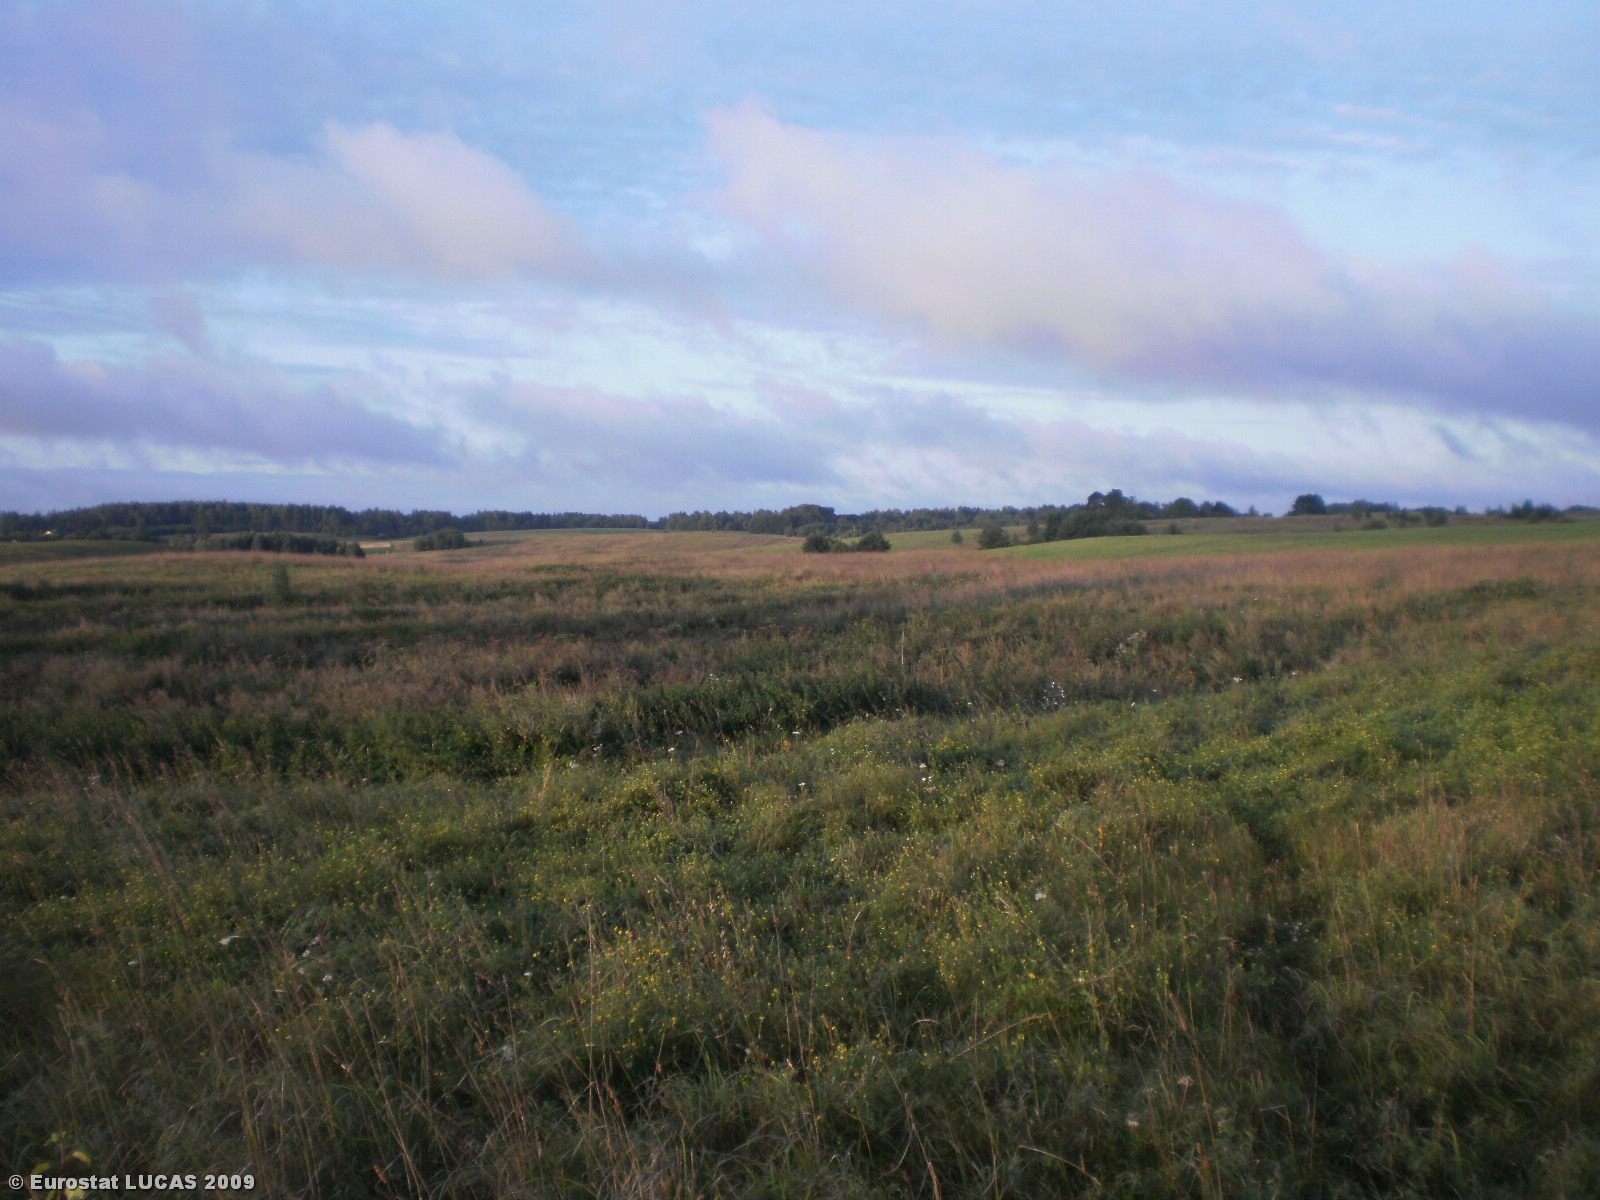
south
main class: Grassland
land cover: Grassland without tree/shrub cover
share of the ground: > 75 %
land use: Agriculture (excluding fallow land and kitchen gardens)
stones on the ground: 10 - 25 %
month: August
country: LT
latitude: 55.0949
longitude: 25.4658
